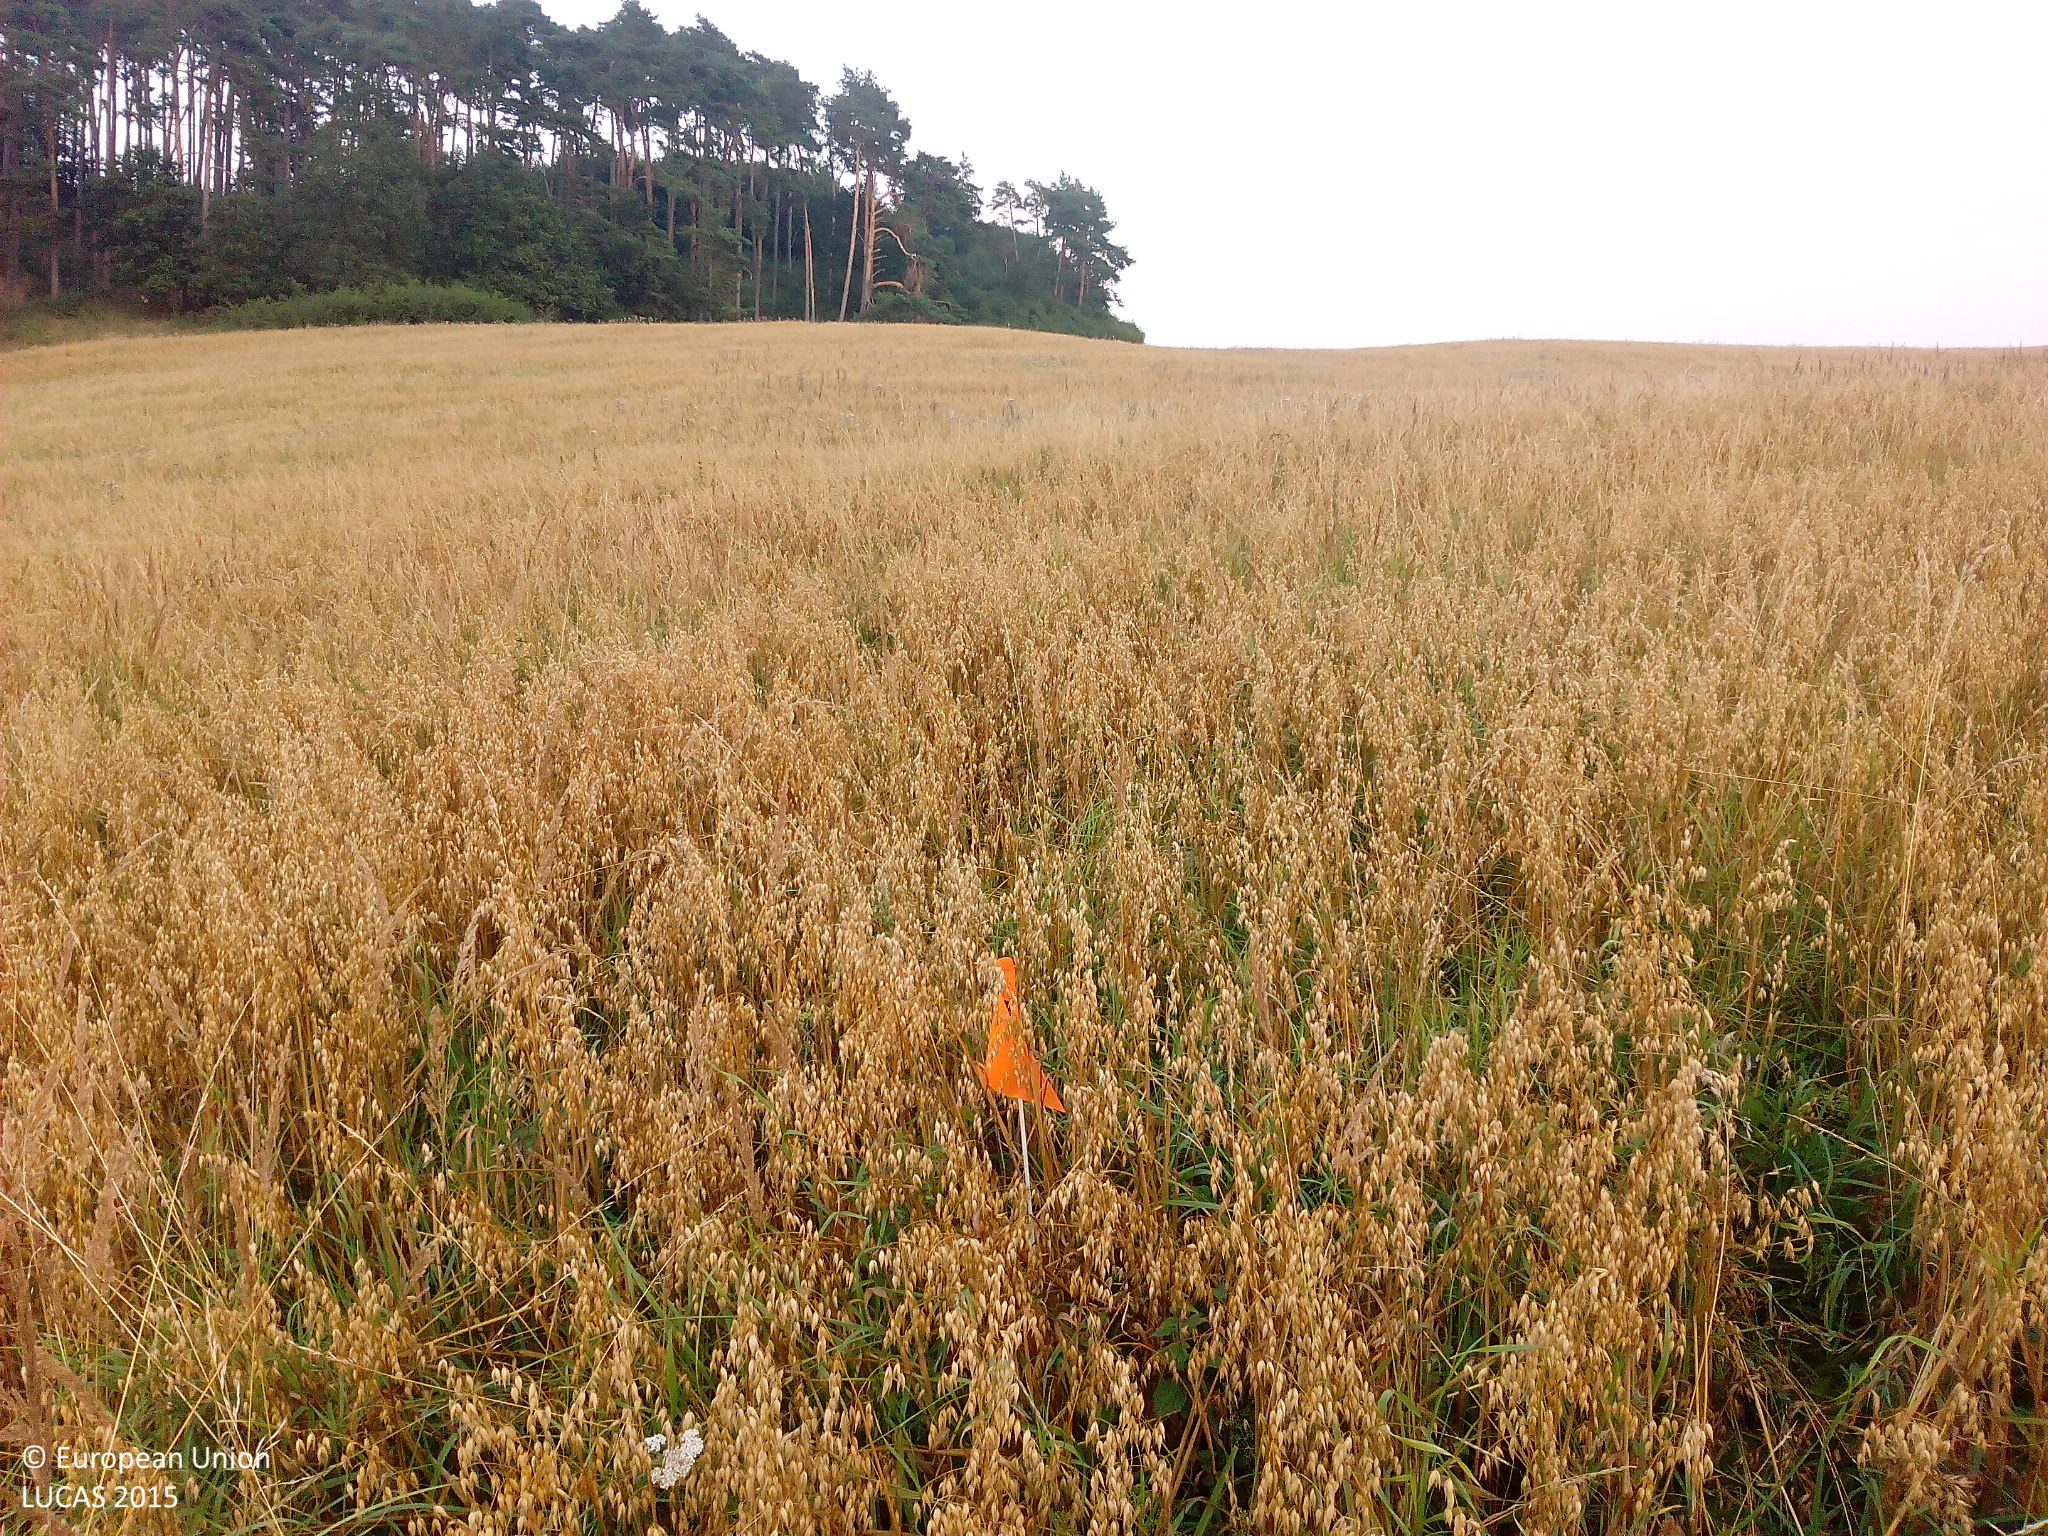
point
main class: Cropland
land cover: Oats
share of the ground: > 75 %
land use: Agriculture (excluding fallow land and kitchen gardens)
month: August
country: DE
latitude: 53.7214
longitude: 12.3178
